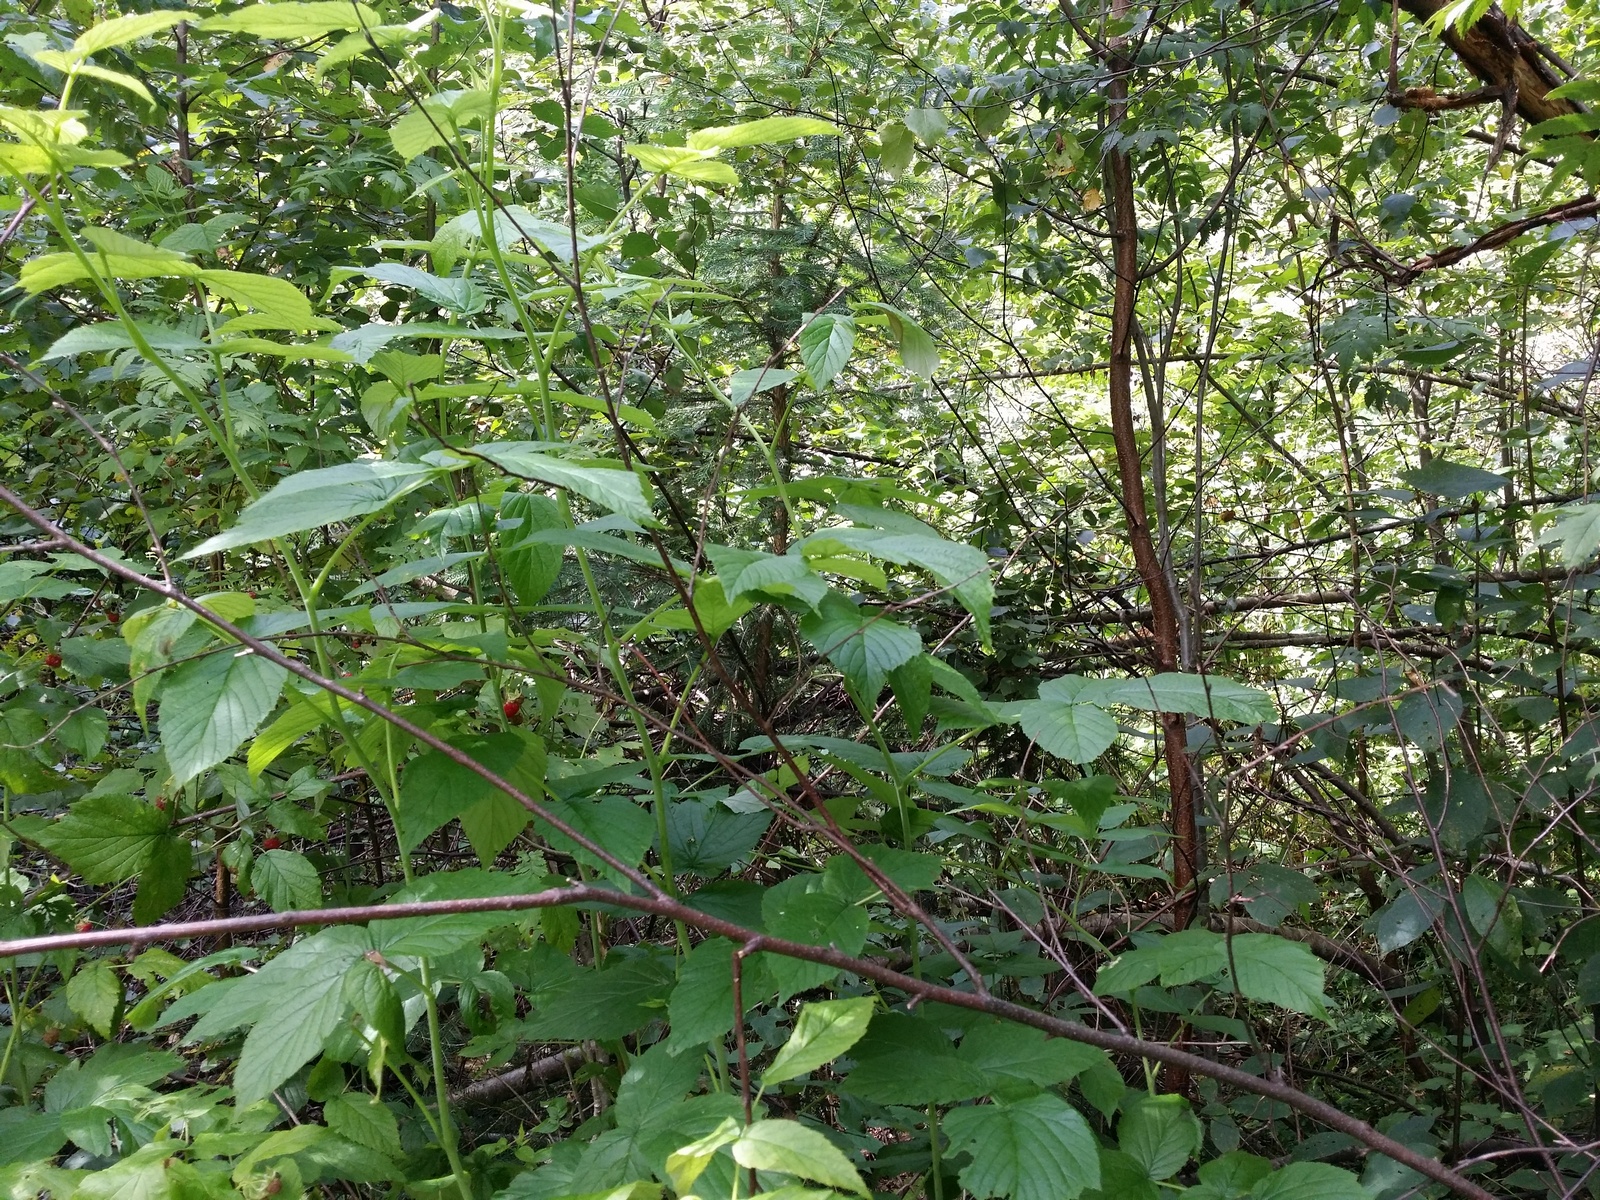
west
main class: Woodland
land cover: Broadleaved woodland
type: non-riverine alder, birch or aspen forest
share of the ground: > 75 %
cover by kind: broadleaved forest trees 90 %, herbaceous plants 10 %
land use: Forestry
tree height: > 5 m
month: August
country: LV
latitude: 57.3979
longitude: 26.8785
